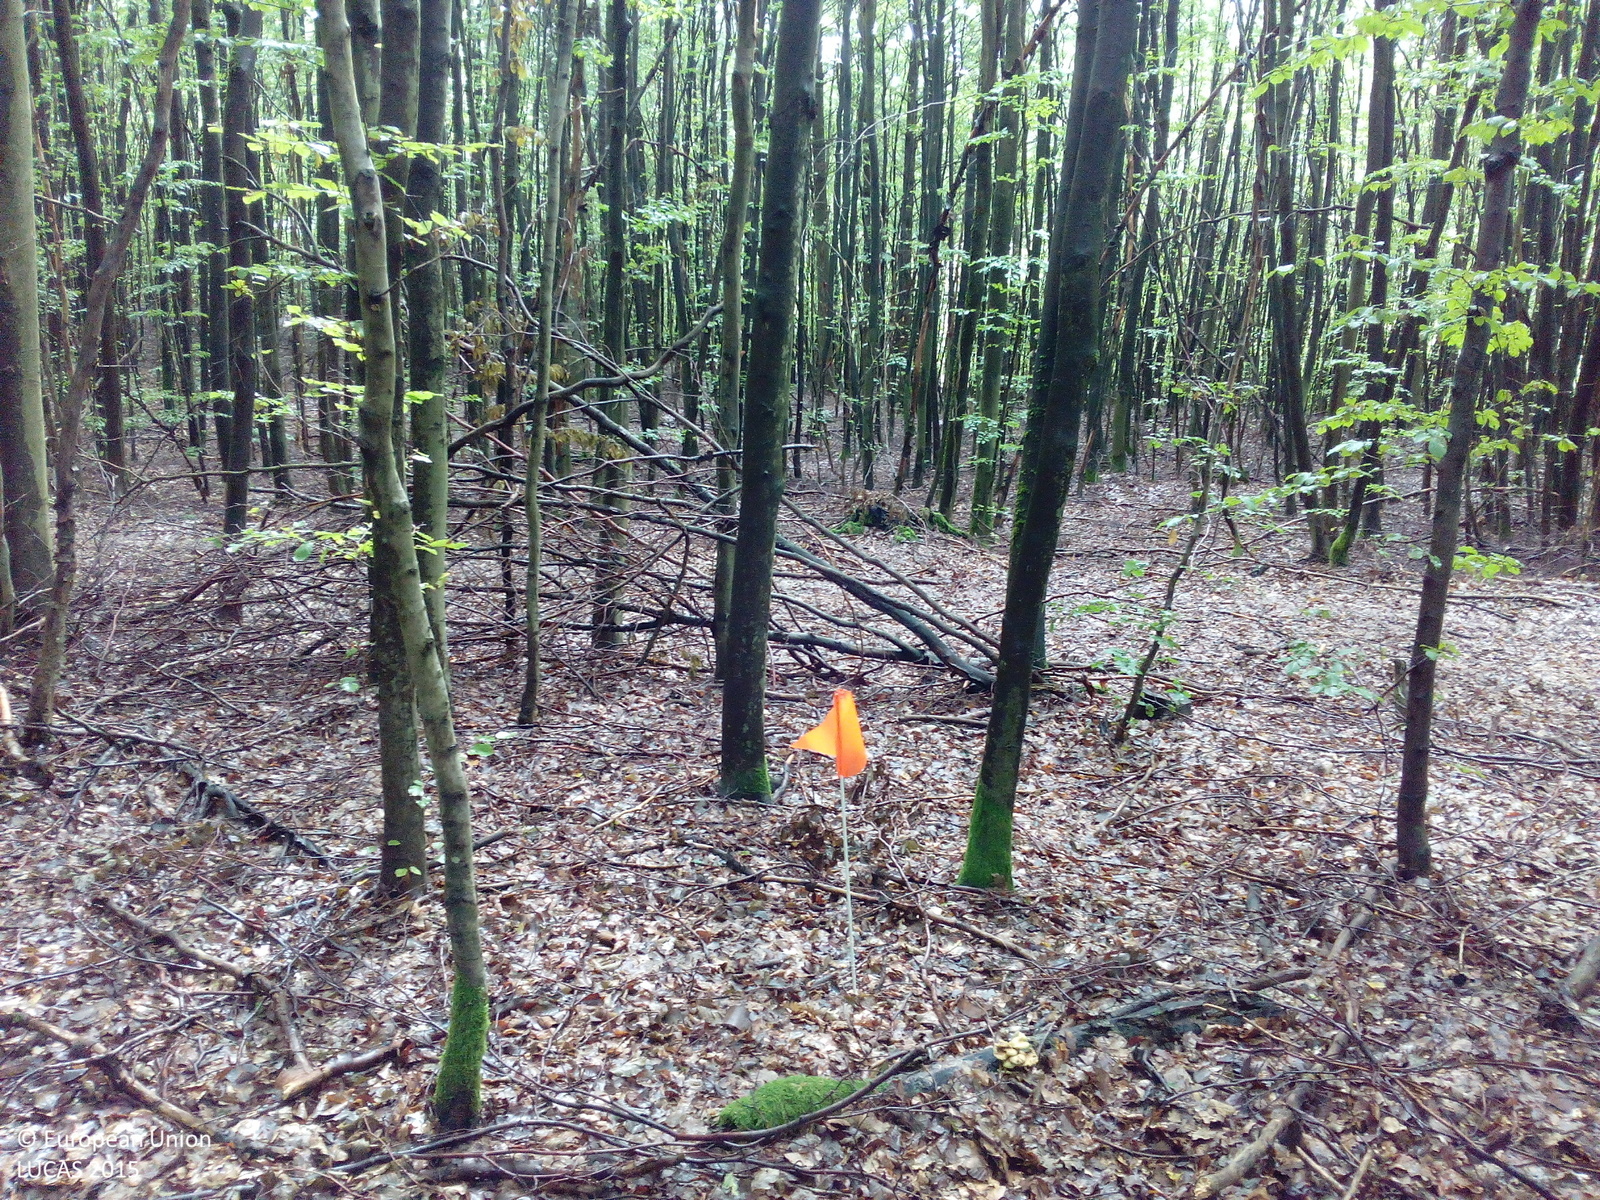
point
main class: Woodland
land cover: Broadleaved woodland
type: beech forest
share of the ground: > 75 %
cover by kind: broadleaved forest trees 100 %
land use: Forestry
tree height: > 5 m
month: September
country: DE
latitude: 50.0755
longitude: 9.5670
